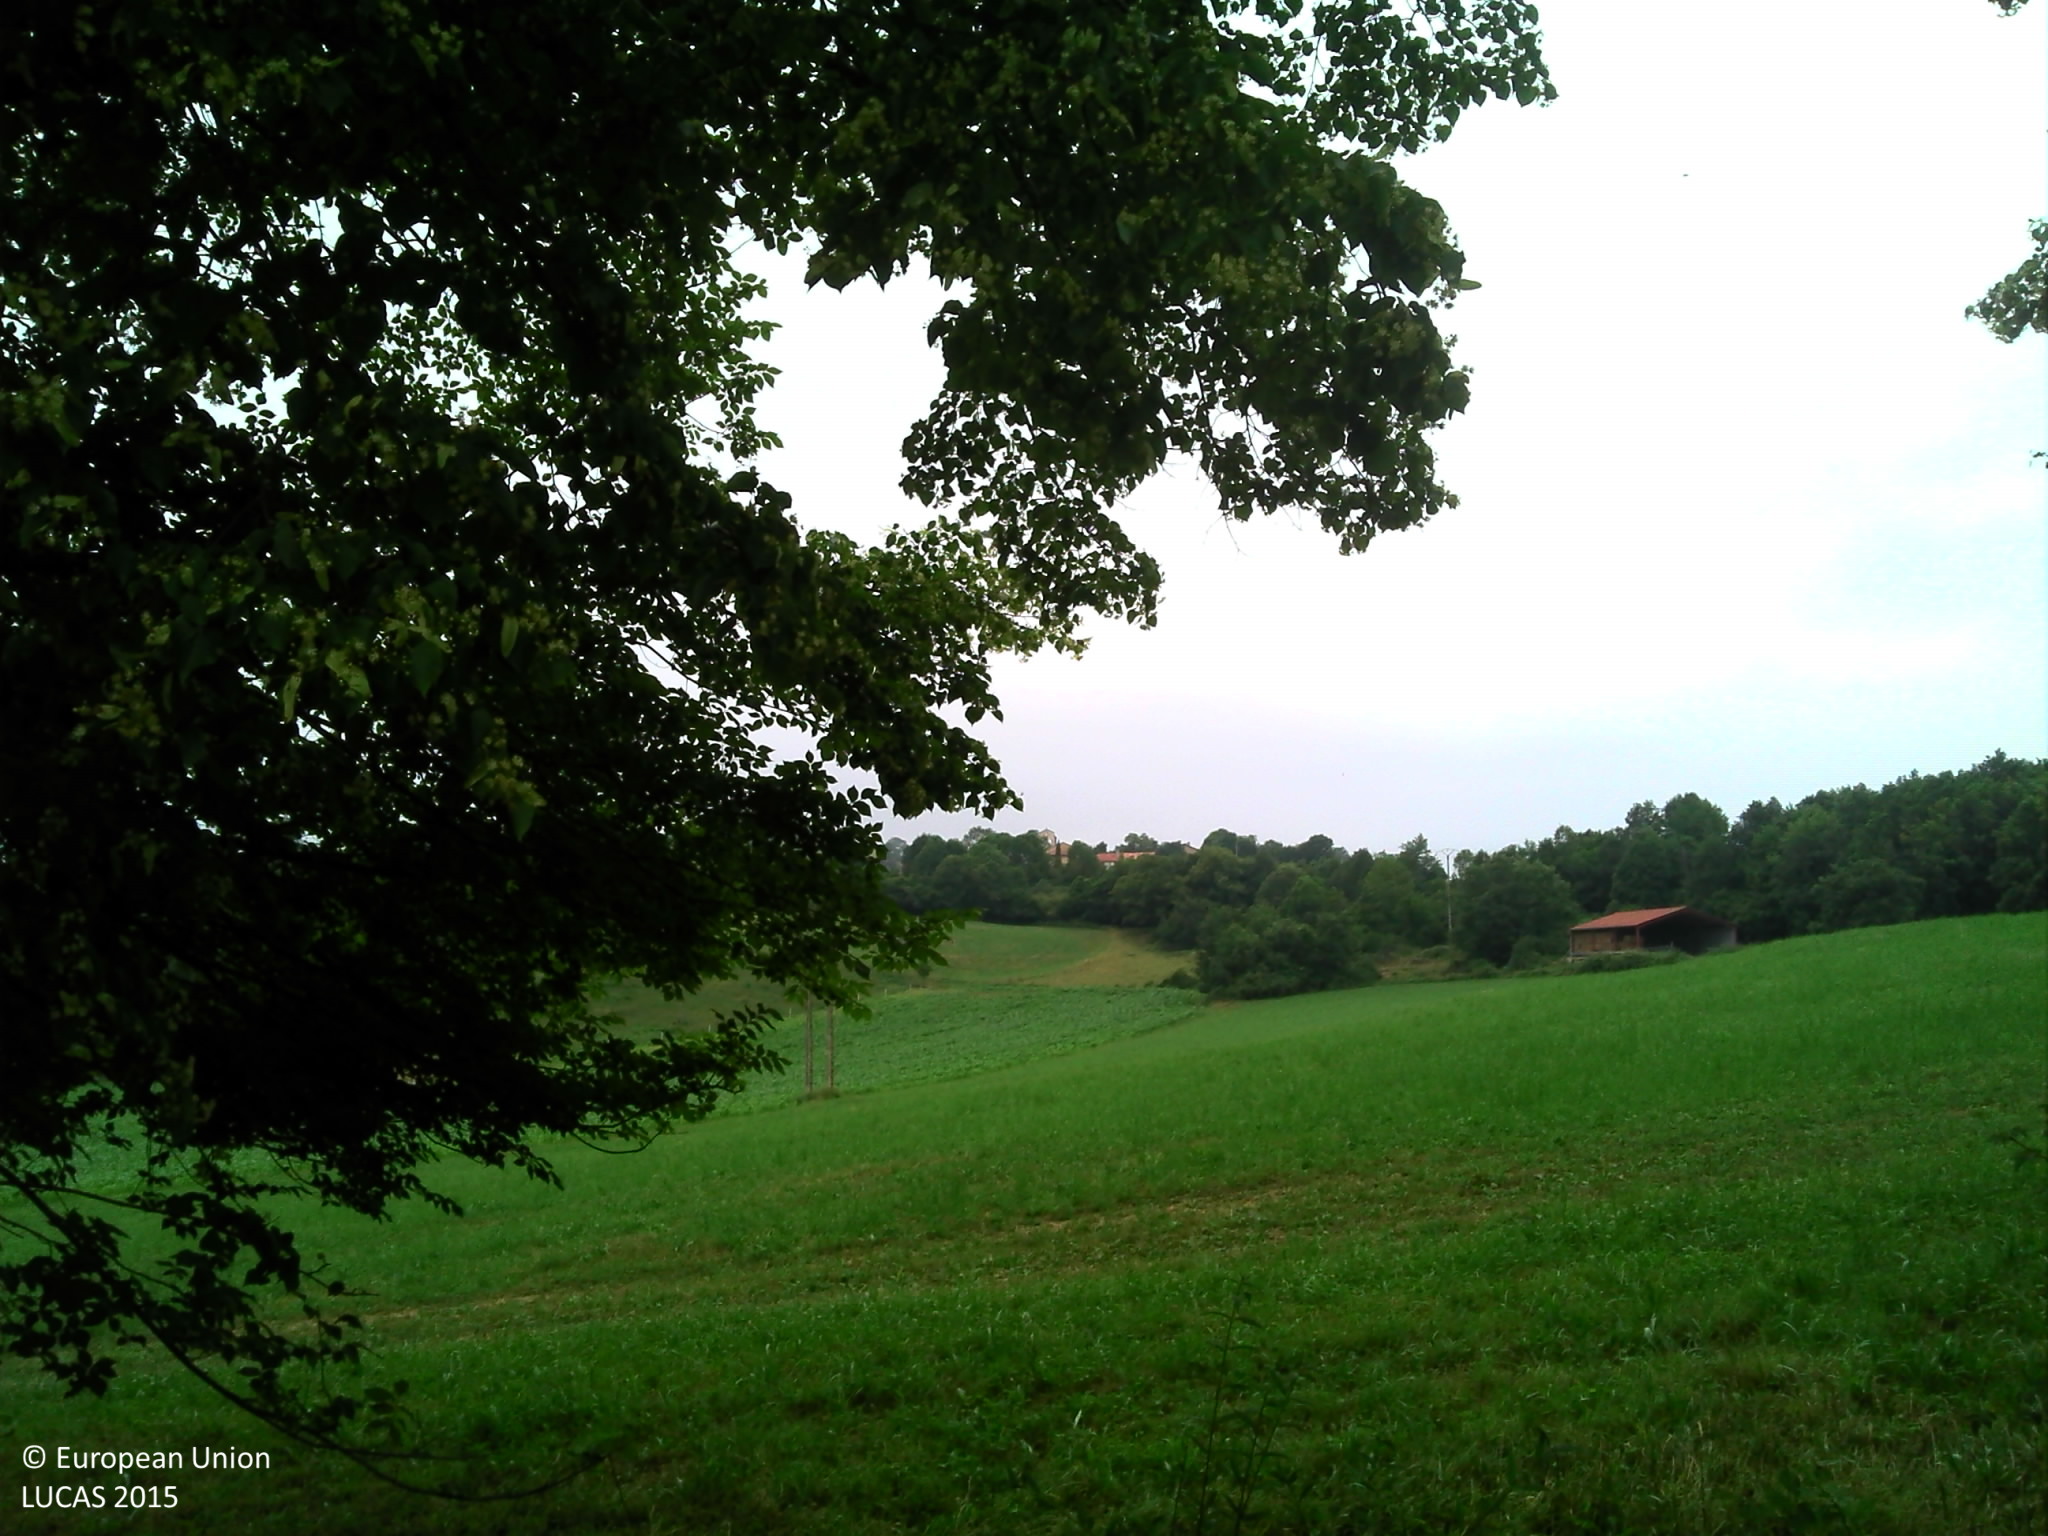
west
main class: Cropland
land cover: Temporary grasslands
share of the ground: > 75 %
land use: Agriculture (excluding fallow land and kitchen gardens)
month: July
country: FR
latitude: 43.0340
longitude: 1.4266
